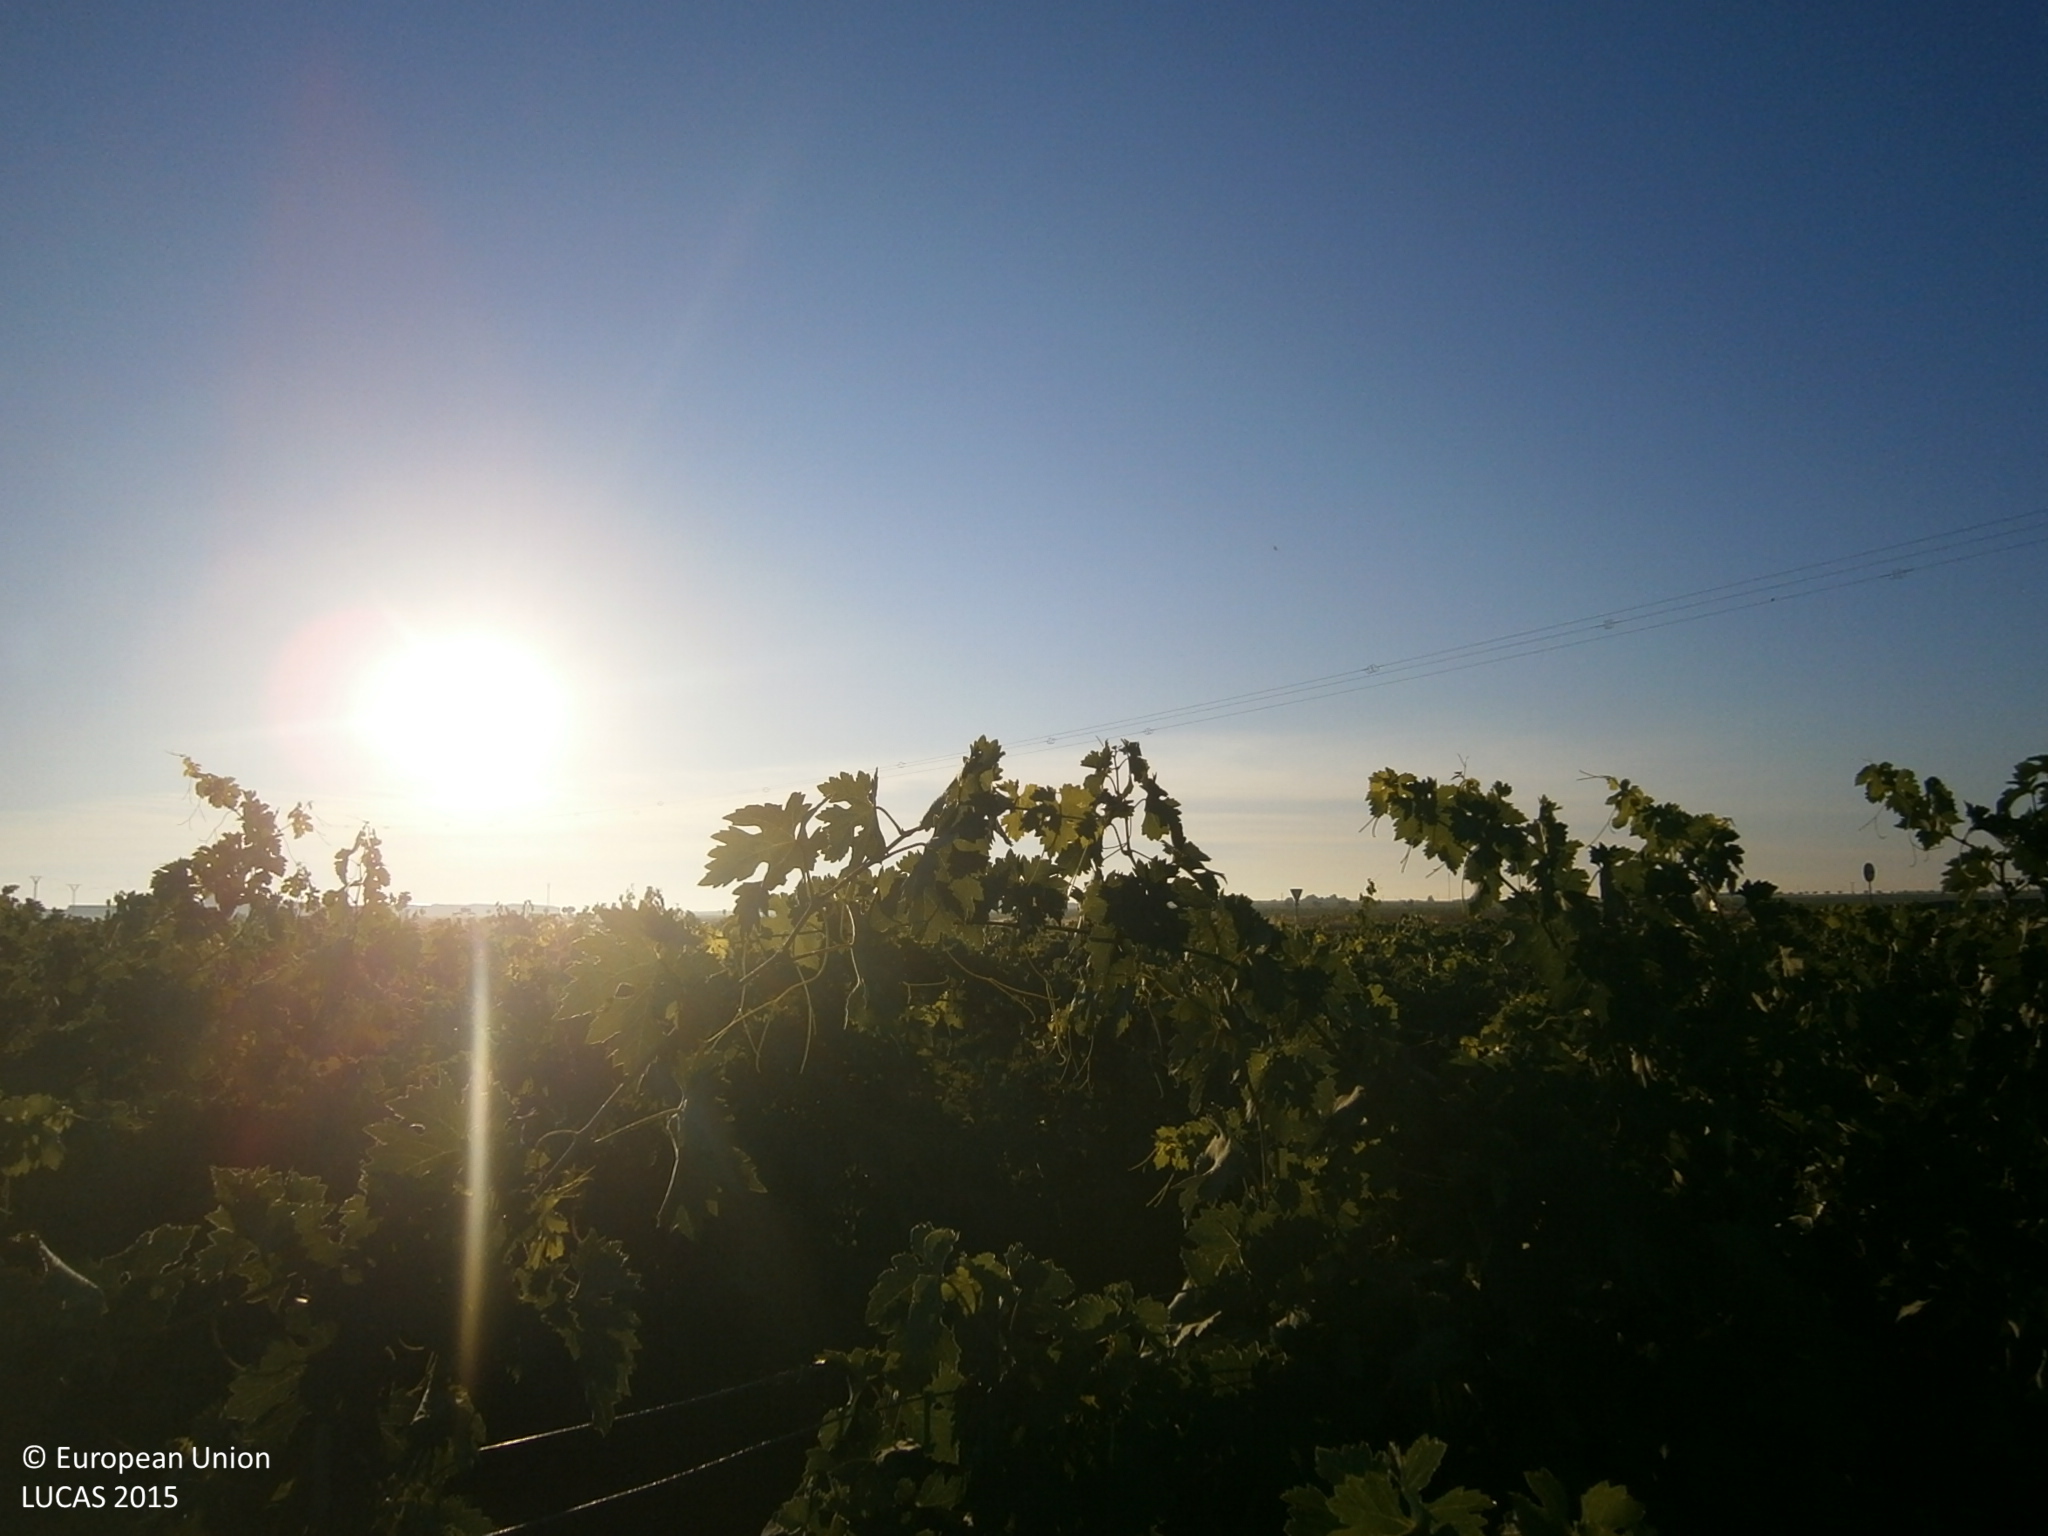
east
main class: Cropland
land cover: Vineyards
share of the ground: 25 - 50 %
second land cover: Other bare soil
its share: > 75 %
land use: Agriculture (excluding fallow land and kitchen gardens)
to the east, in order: Vineyards; Other bare soil; Tracks; Spontaneously vegetated surfaces; Paved roads, cycling and walking lanes; Spontaneously vegetated surfaces; Rivers and streams; Spontaneously vegetated surfaces; Vineyards
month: June
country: ES
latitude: 38.7075
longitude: -6.4192
